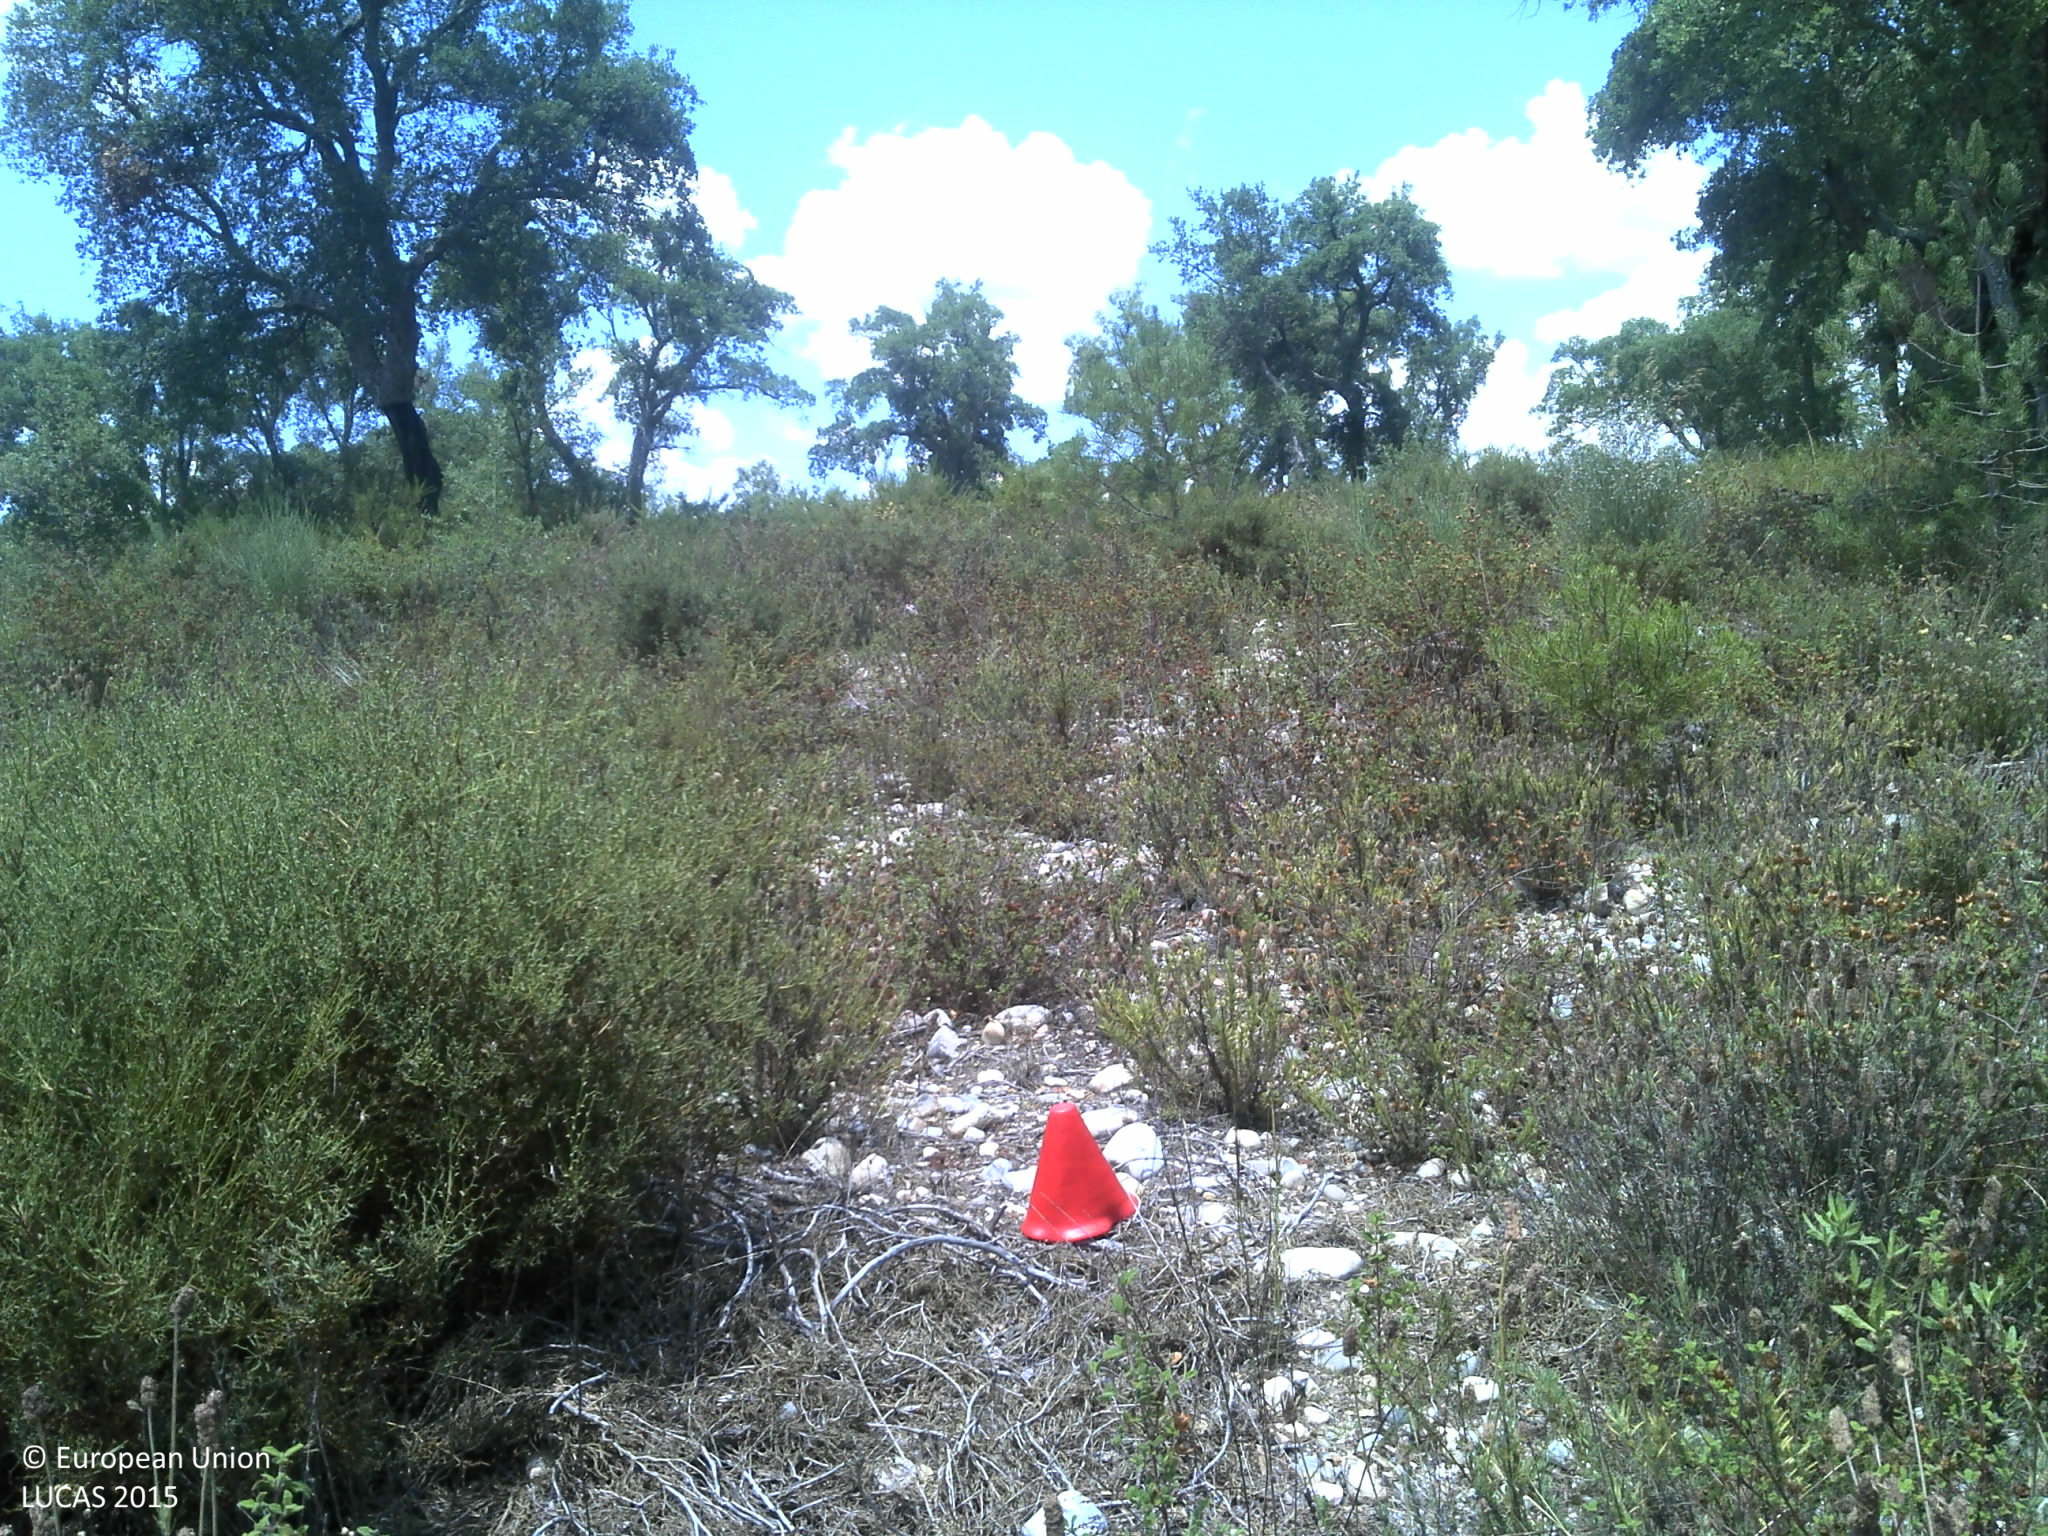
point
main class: Woodland
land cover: Broadleaved woodland
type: broadleaved evergreen forest
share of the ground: 10 - 25 %
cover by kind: unconsolidated bare surface 40 %, broadleaved forest trees 25 %, shrubs 25 %, herbaceous plants 10 %
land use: Forestry
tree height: > 5 m
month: June
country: PT
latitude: 39.2745
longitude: -8.2726
